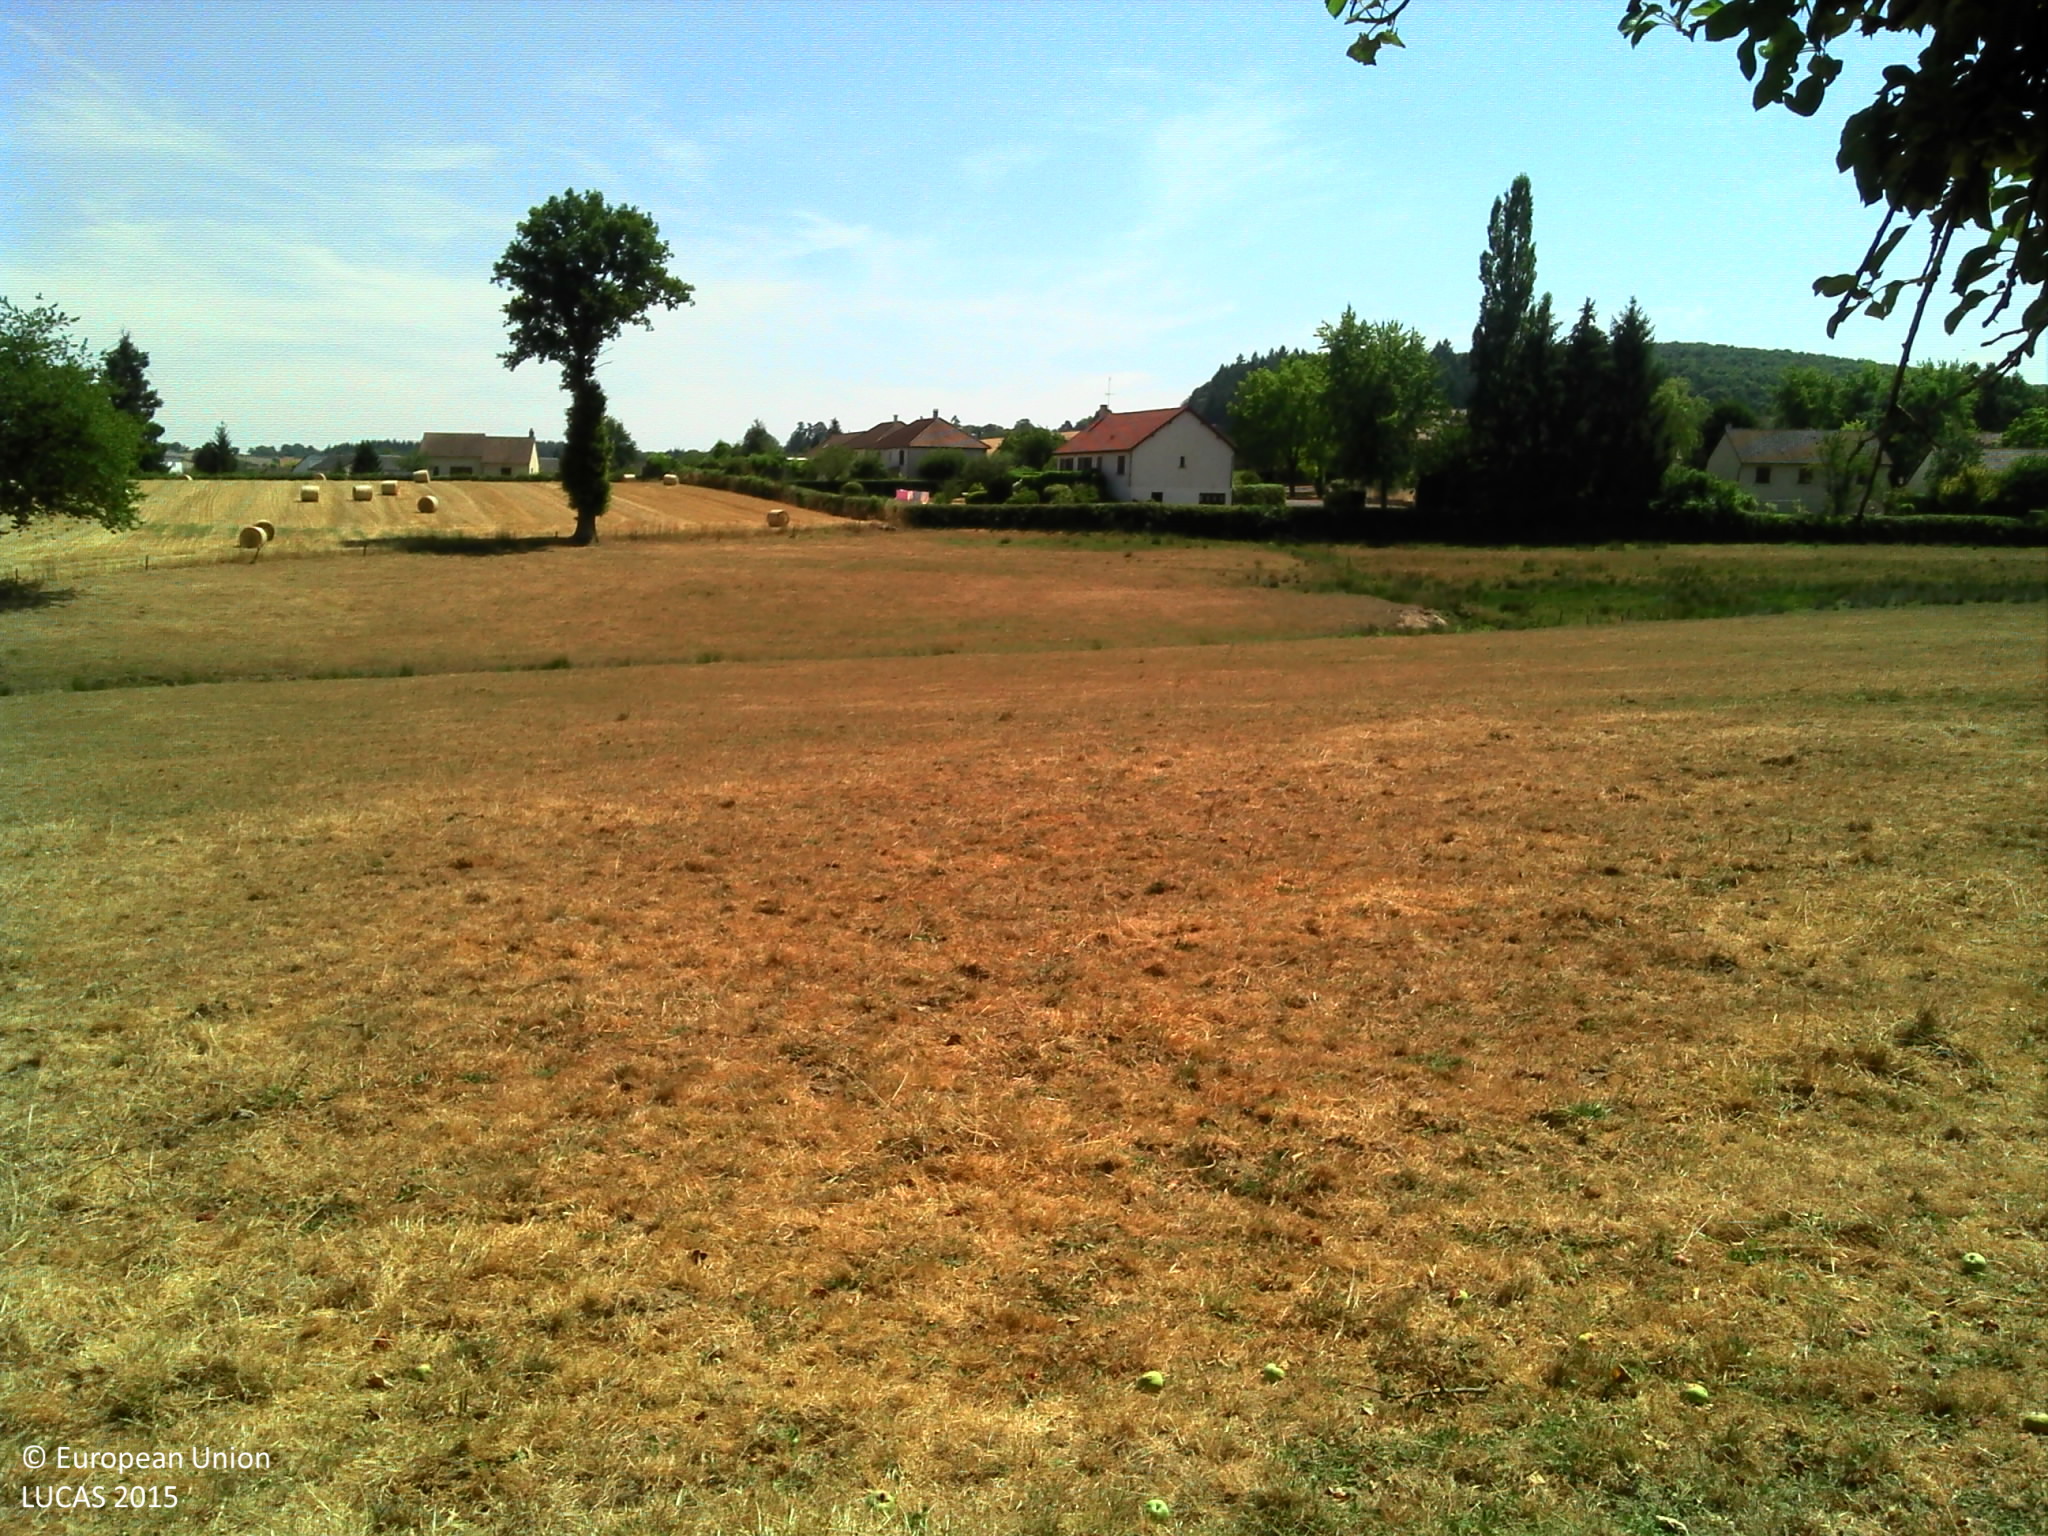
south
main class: Cropland
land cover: Apple fruit
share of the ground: 50 - 75 %
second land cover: Grassland without tree/shrub cover
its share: 25 - 50 %
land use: Agriculture (excluding fallow land and kitchen gardens)
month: July
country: FR
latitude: 46.7945
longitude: 3.9598
